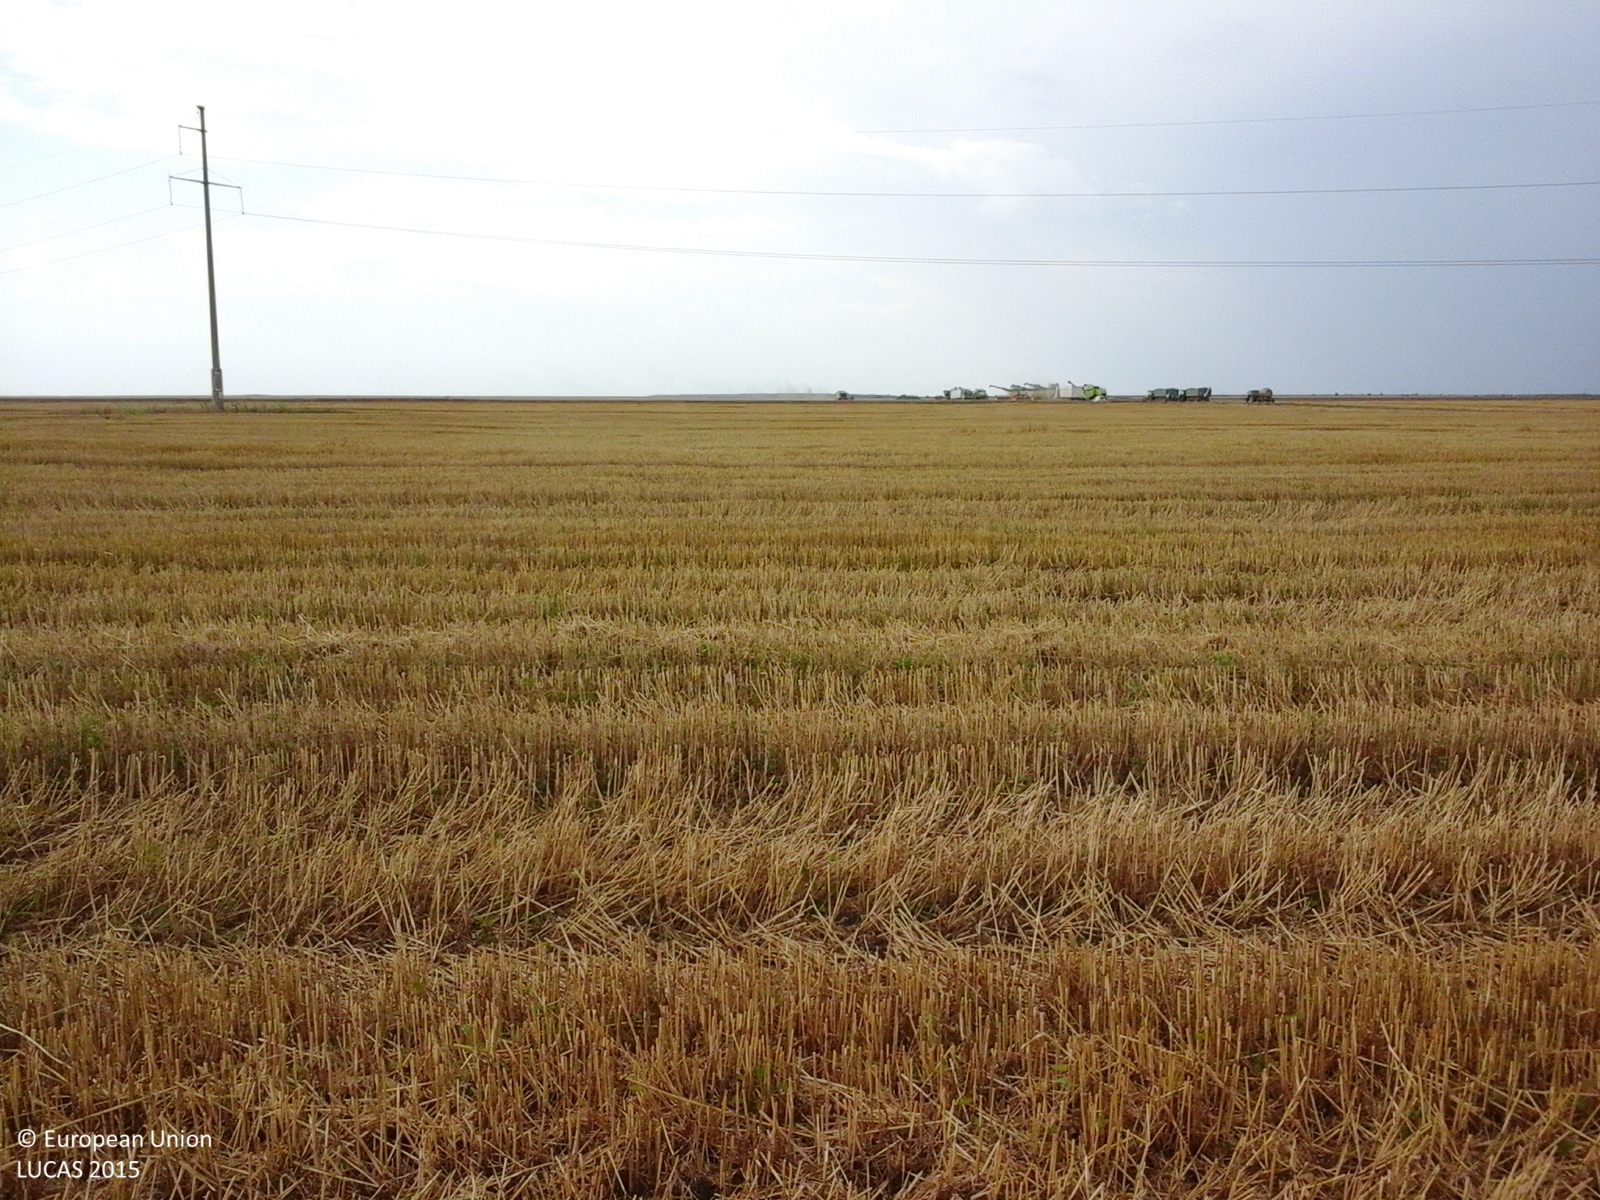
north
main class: Cropland
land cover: Common wheat
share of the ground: < 10 %
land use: Agriculture (excluding fallow land and kitchen gardens)
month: July
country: RO
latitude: 43.8941
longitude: 24.4934
